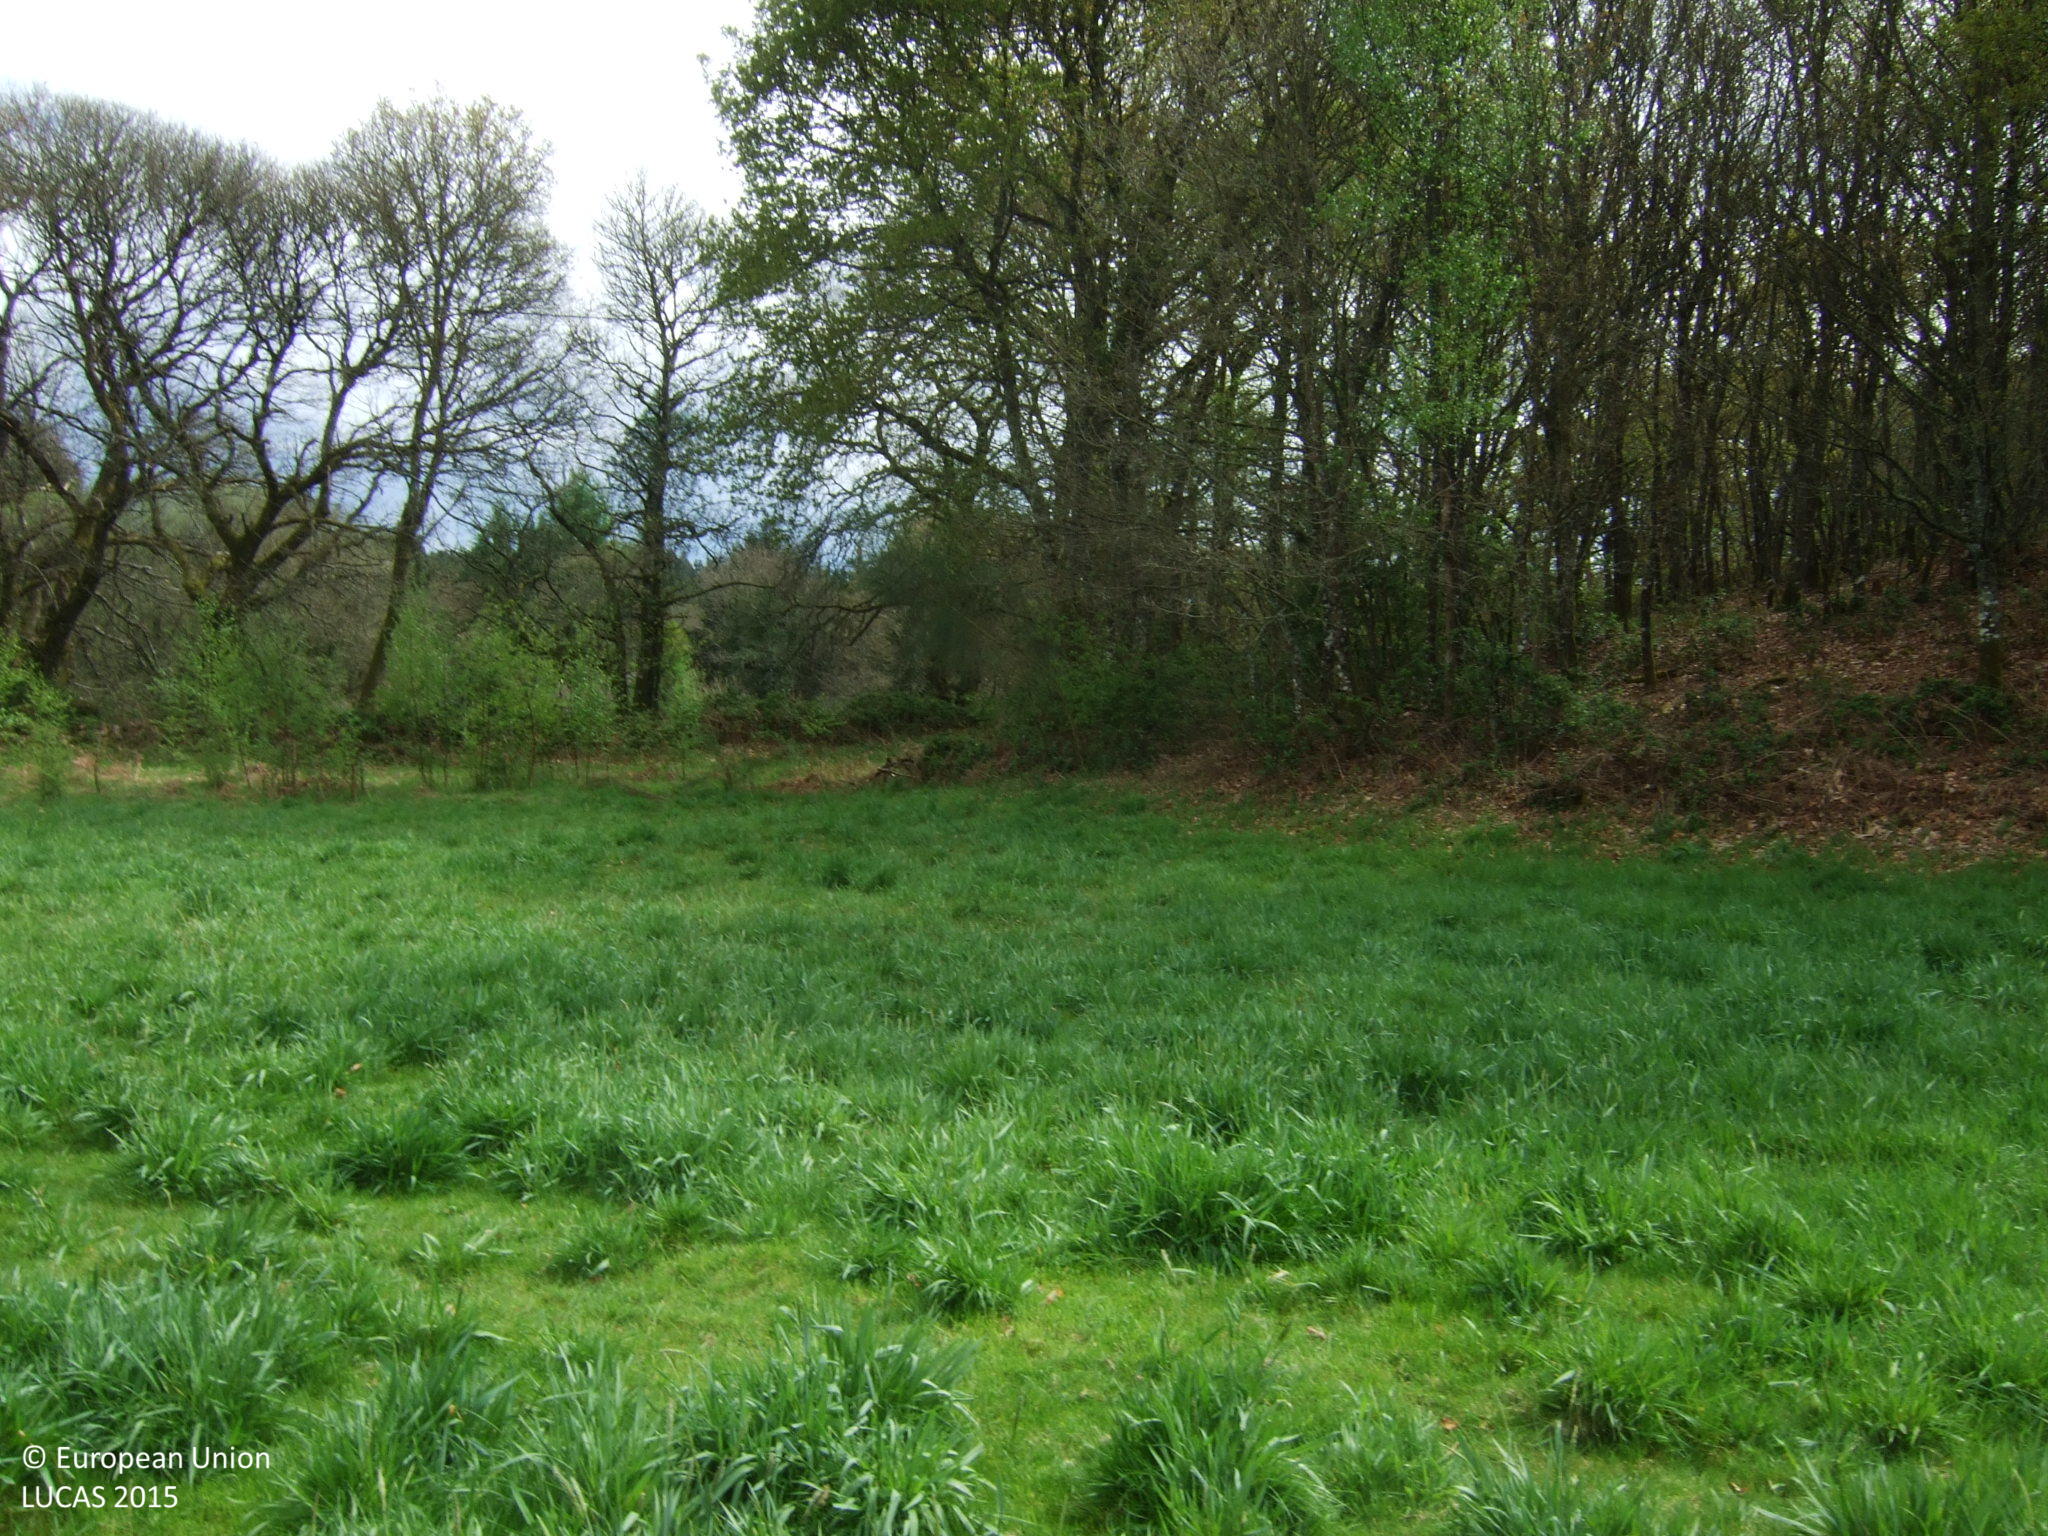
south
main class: Grassland
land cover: Grassland without tree/shrub cover
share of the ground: > 75 %
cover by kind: herbaceous plants 100 %
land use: Agriculture (excluding fallow land and kitchen gardens)
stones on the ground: < 10 %
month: April
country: ES
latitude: 43.0107
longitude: -7.8383
